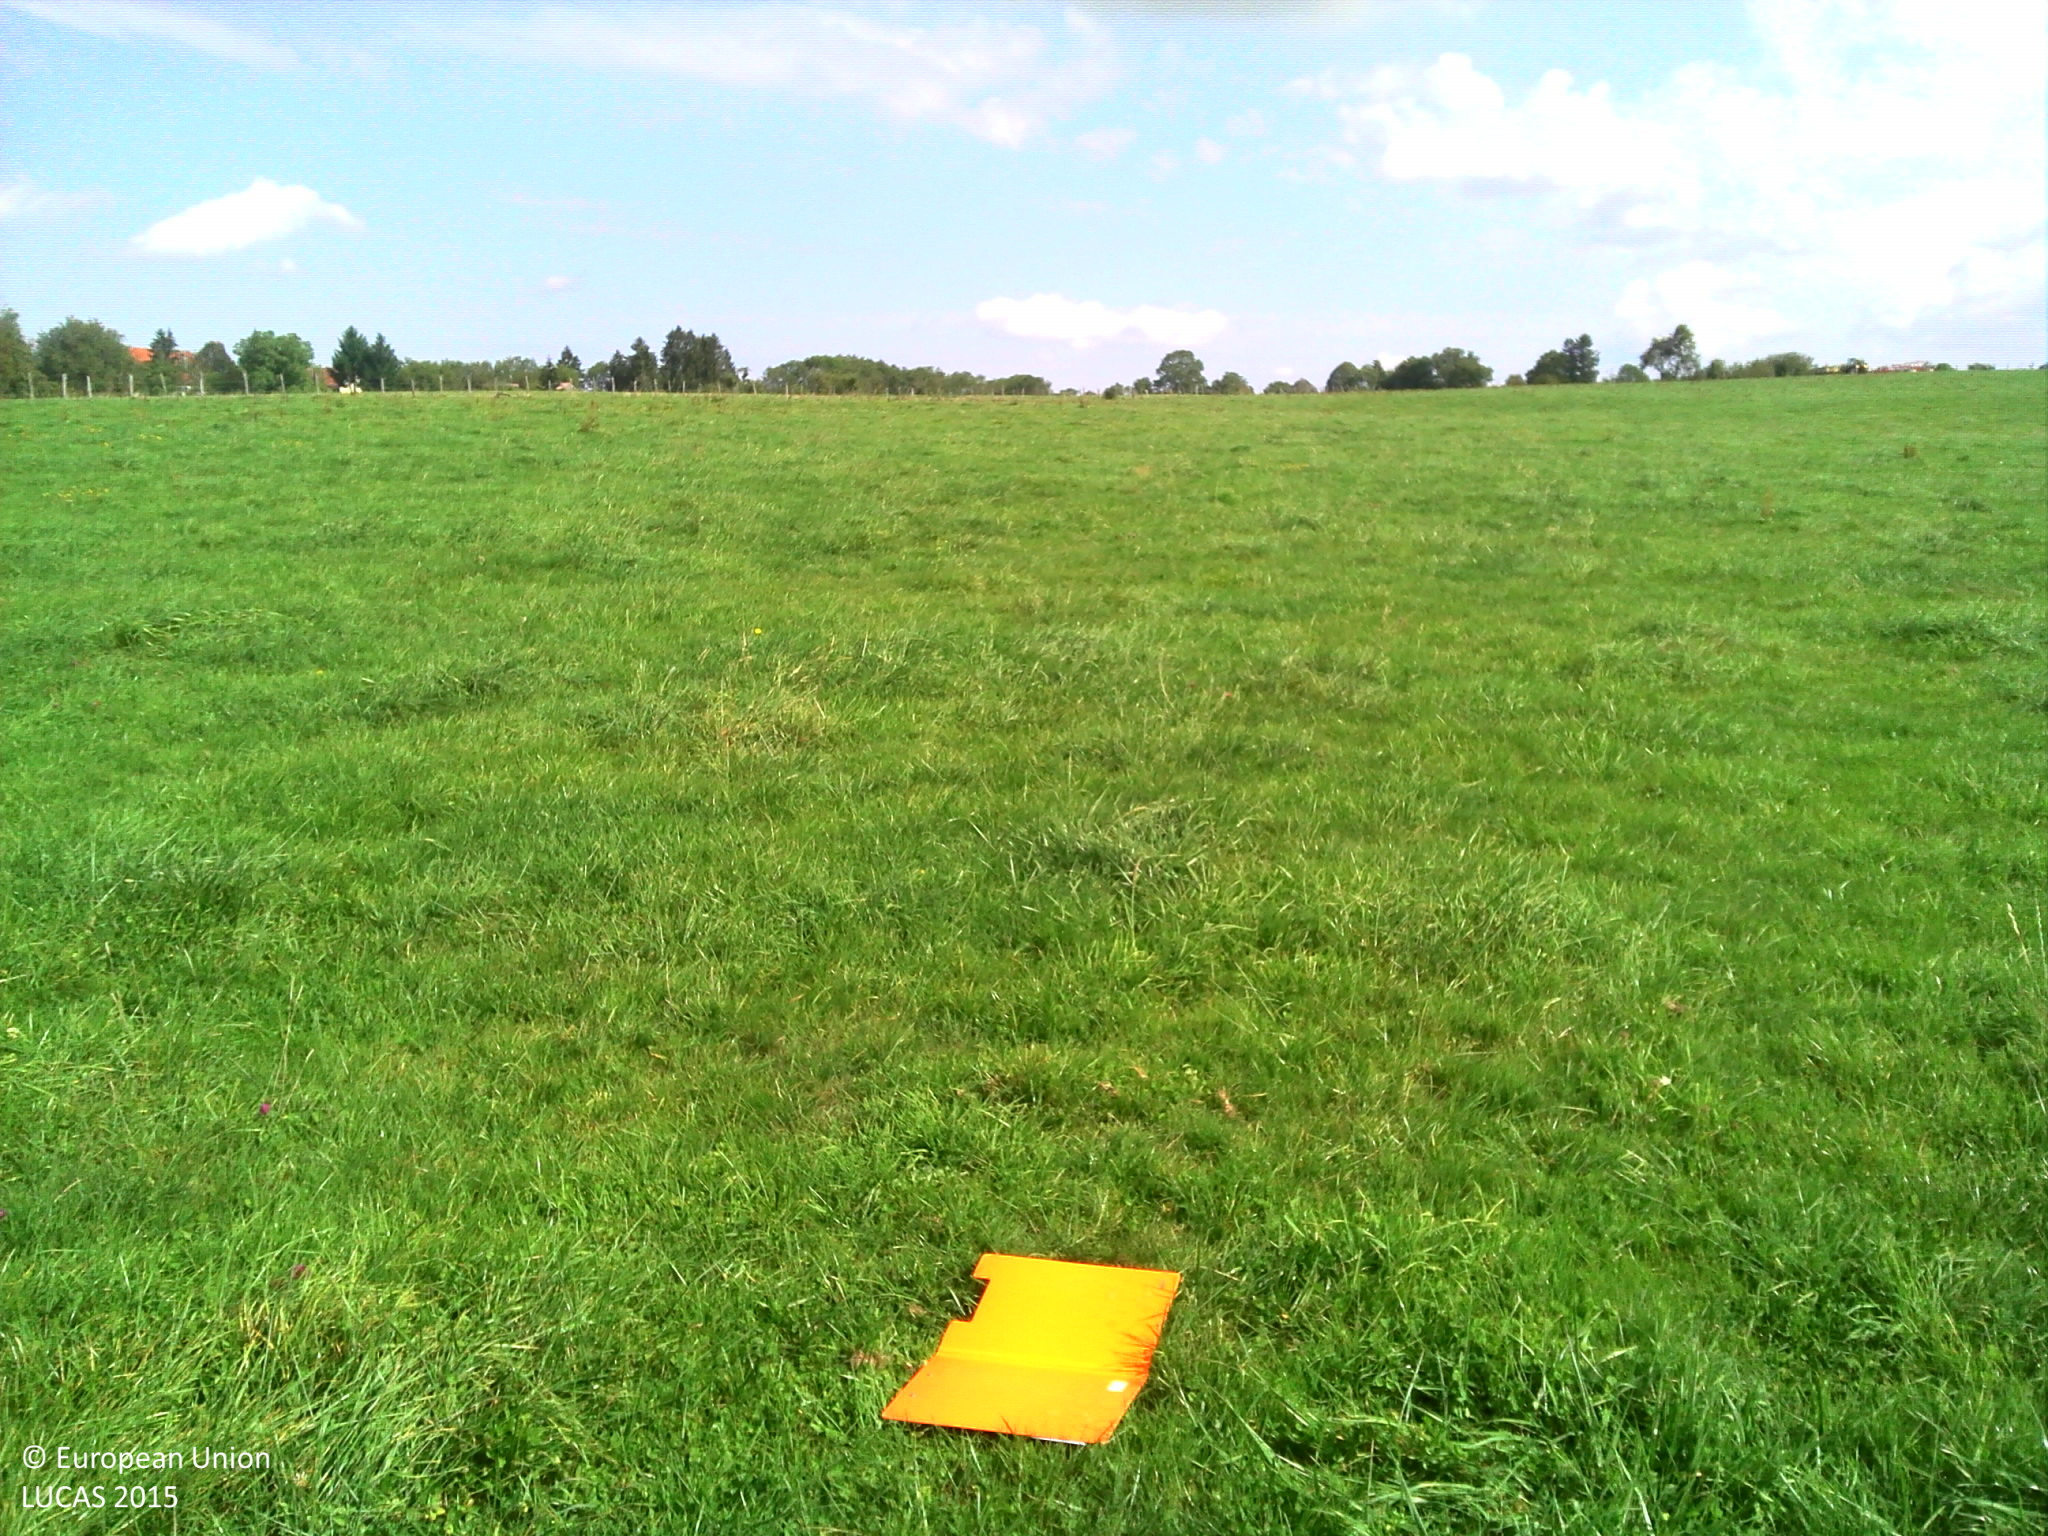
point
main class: Grassland
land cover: Grassland without tree/shrub cover
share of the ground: > 75 %
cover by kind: herbaceous plants 100 %
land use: Agriculture (excluding fallow land and kitchen gardens)
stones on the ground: < 10 %
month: September
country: FR
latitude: 47.1730
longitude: 6.3737
